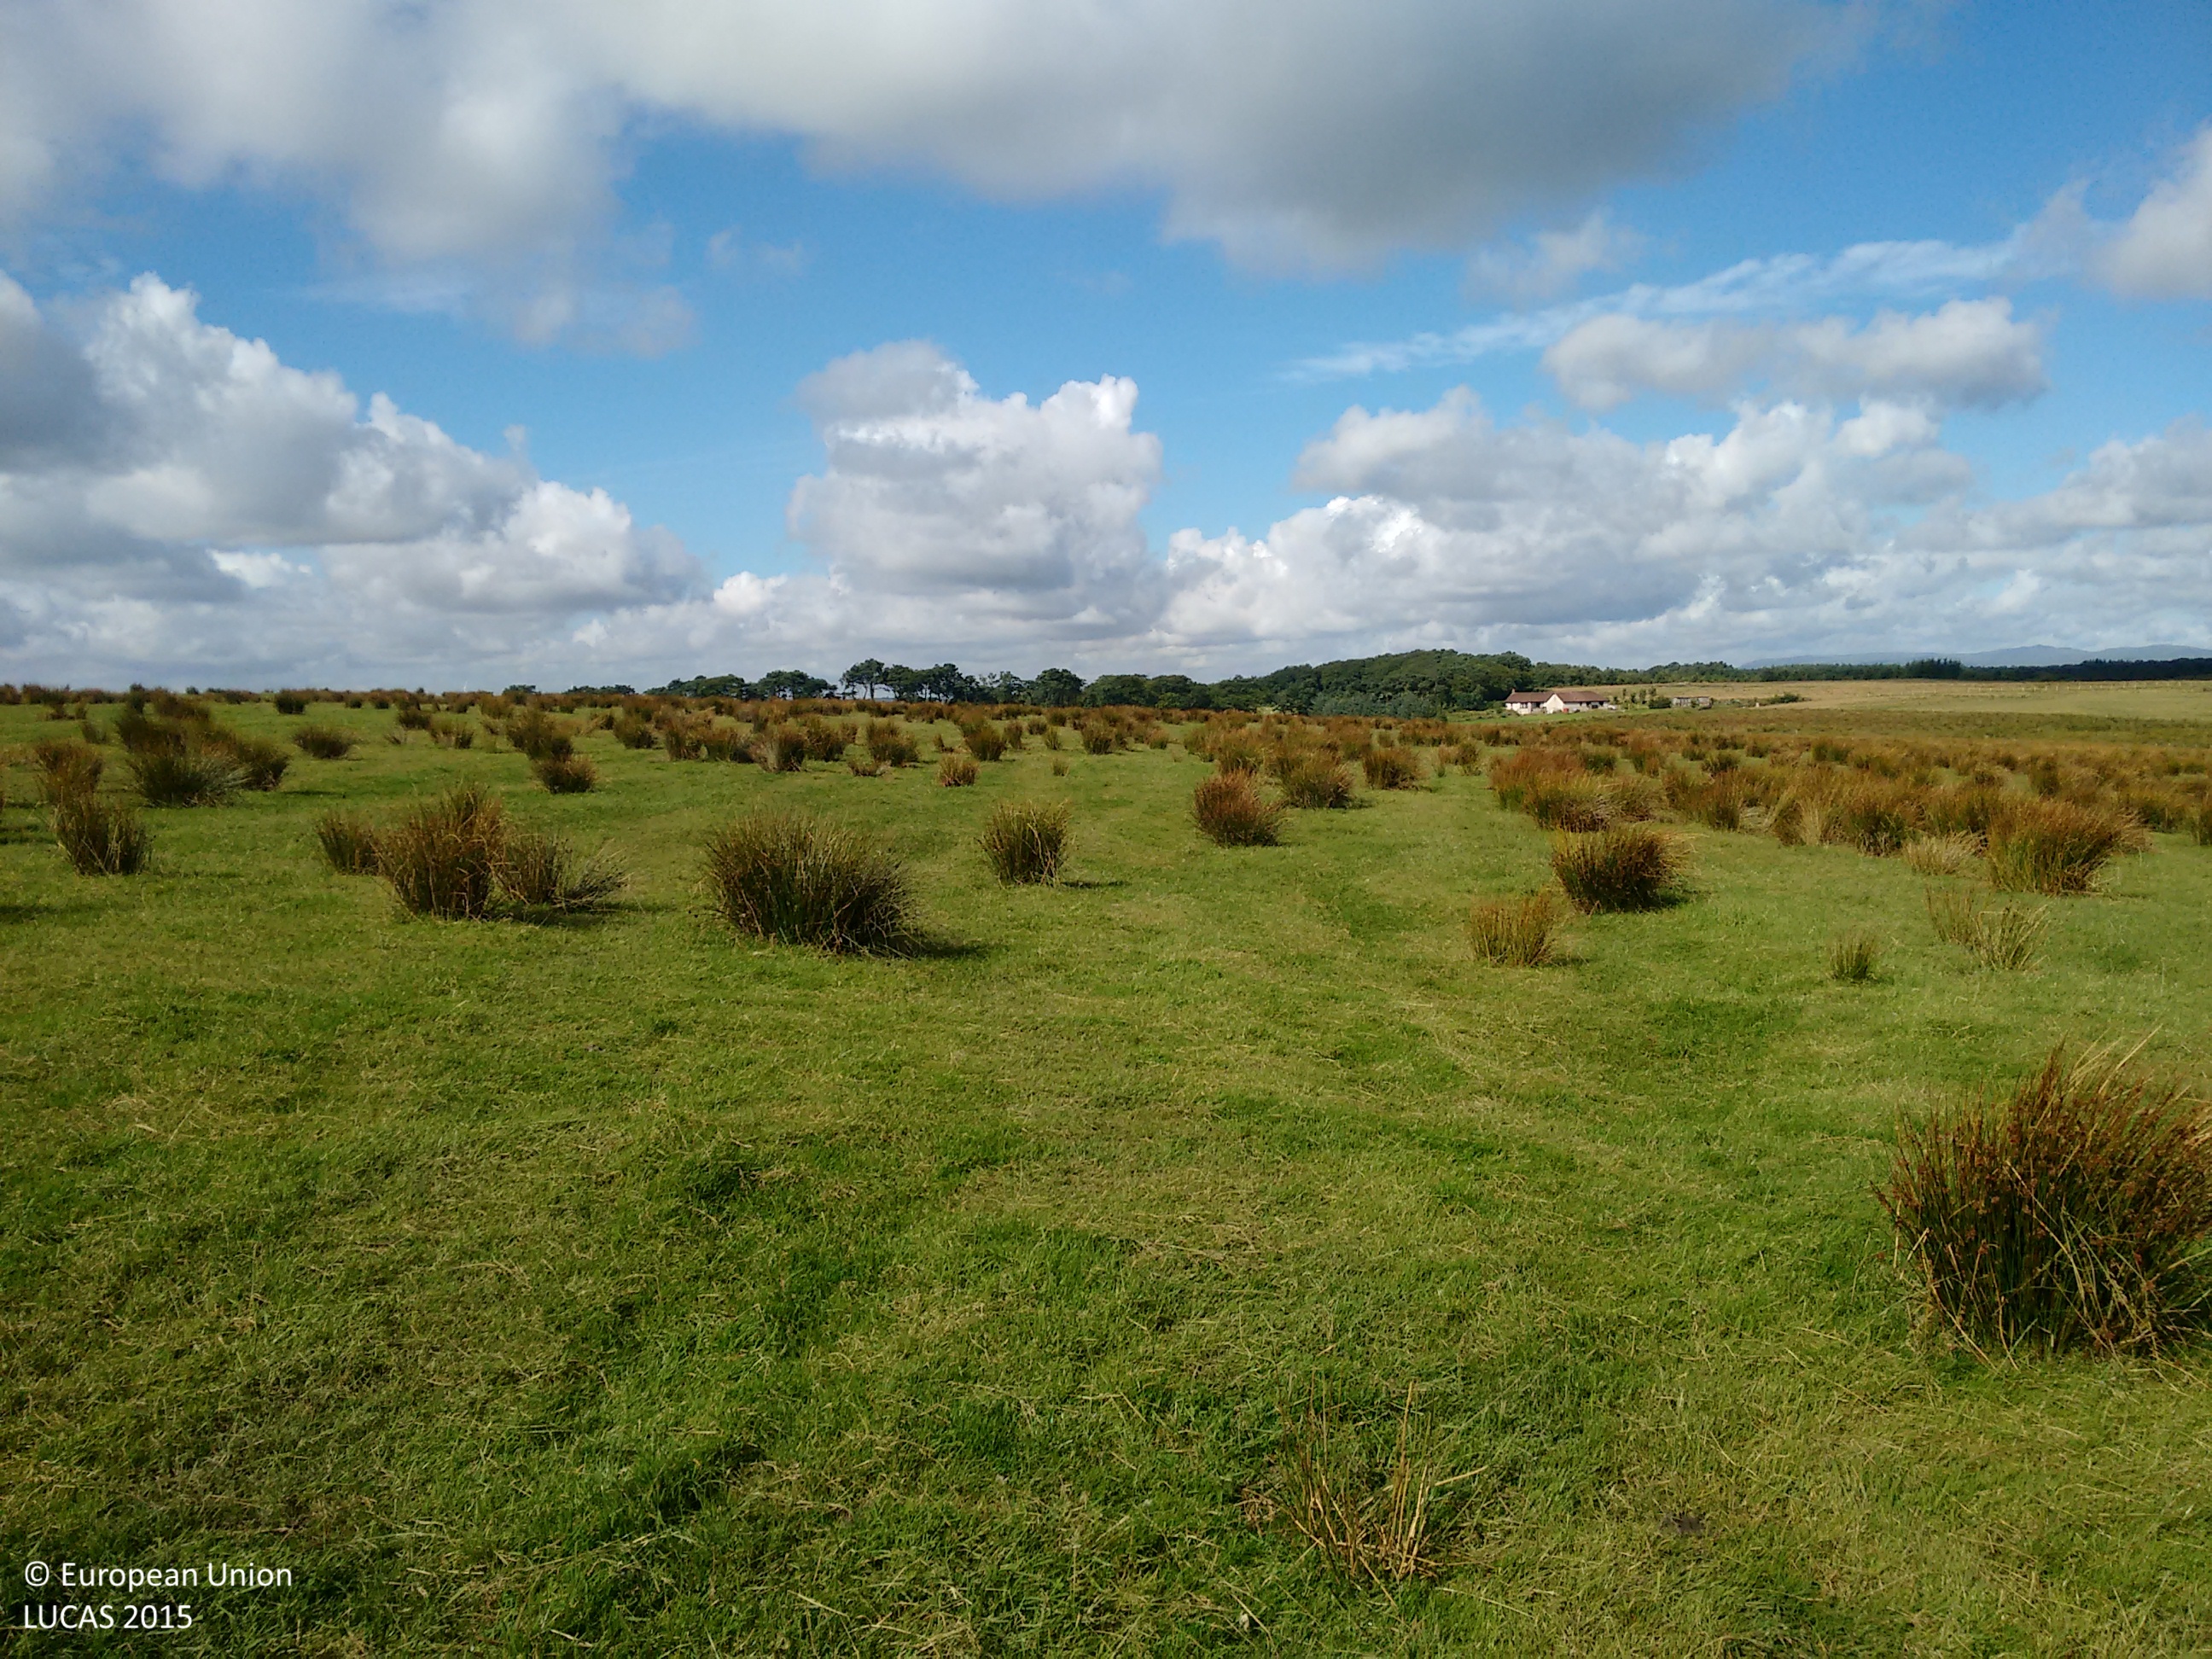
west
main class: Grassland
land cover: Grassland without tree/shrub cover
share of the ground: > 75 %
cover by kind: herbaceous plants 100 %
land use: Agriculture (excluding fallow land and kitchen gardens)
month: August
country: GB
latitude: 55.9515
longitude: -3.7754
